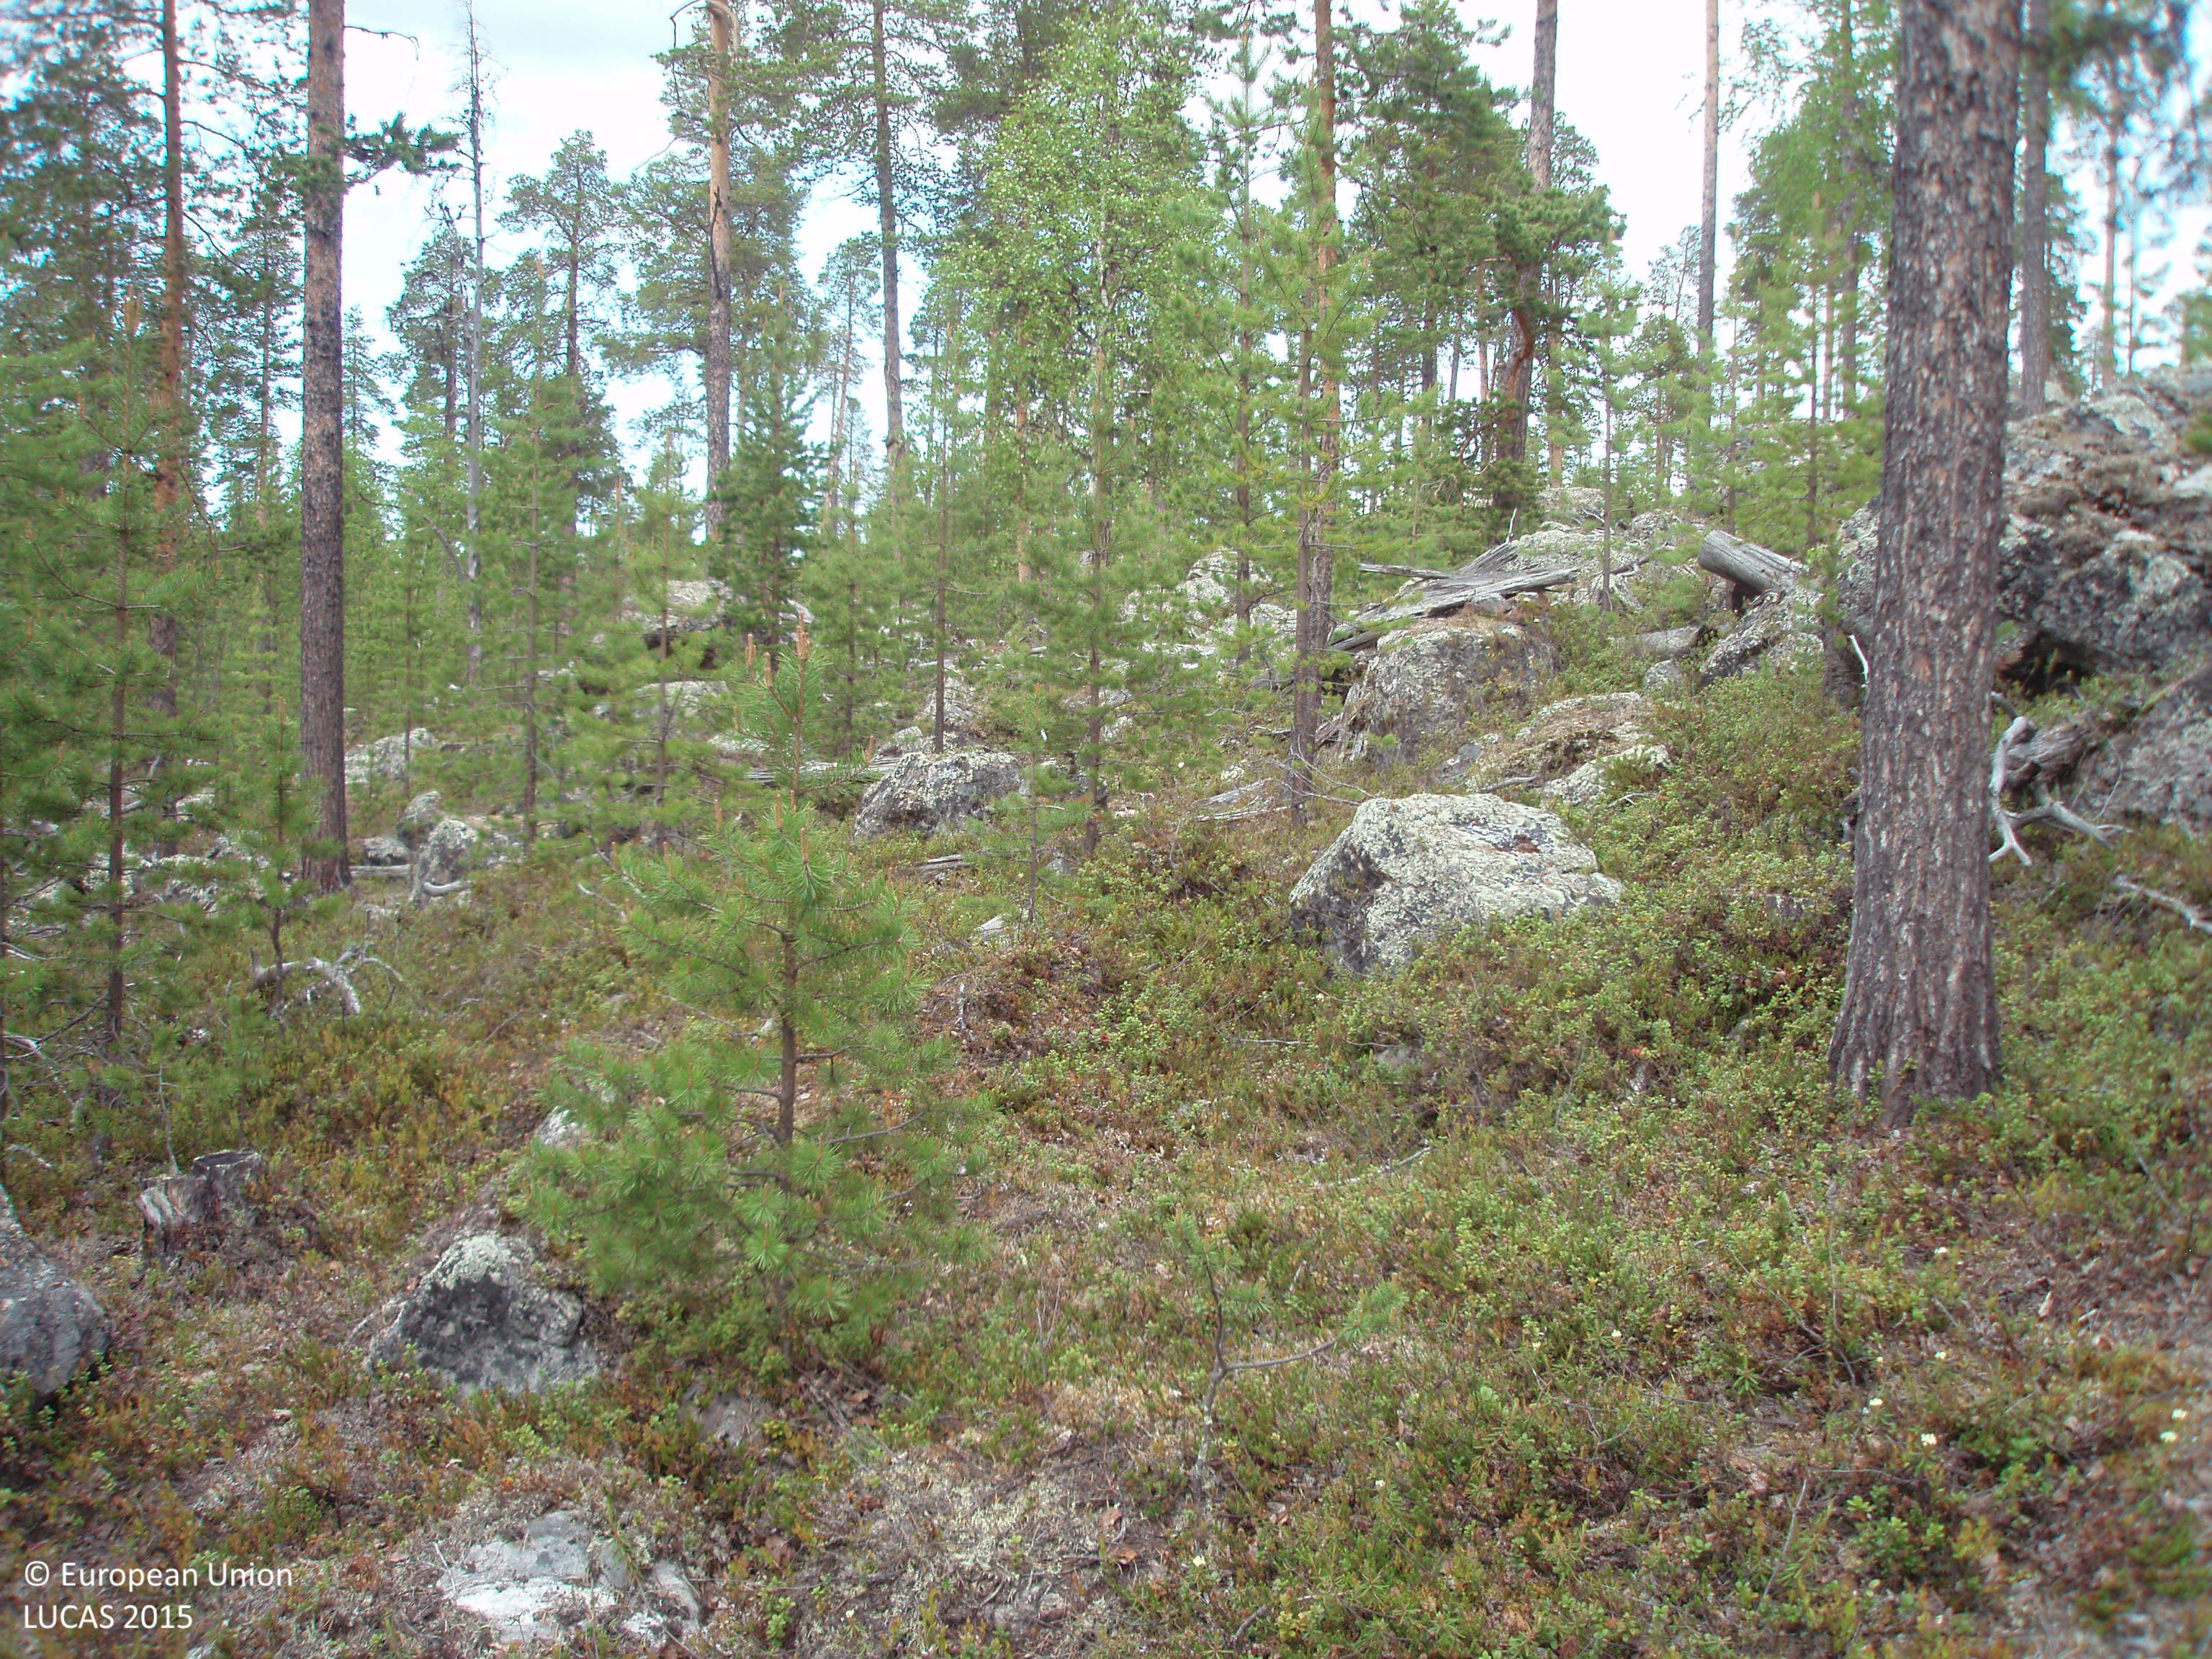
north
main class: Woodland
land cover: Pine dominated coniferous woodland
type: boreal forest
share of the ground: 25 - 50 %
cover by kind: shrubs 55 %, coniferous forest trees 30 %, broadleaved forest trees 5 %, lichens and mosses 5 %, unconsolidated bare surface 5 %
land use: Forestry
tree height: > 5 m
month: June
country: FI
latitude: 68.8054
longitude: 28.1104
